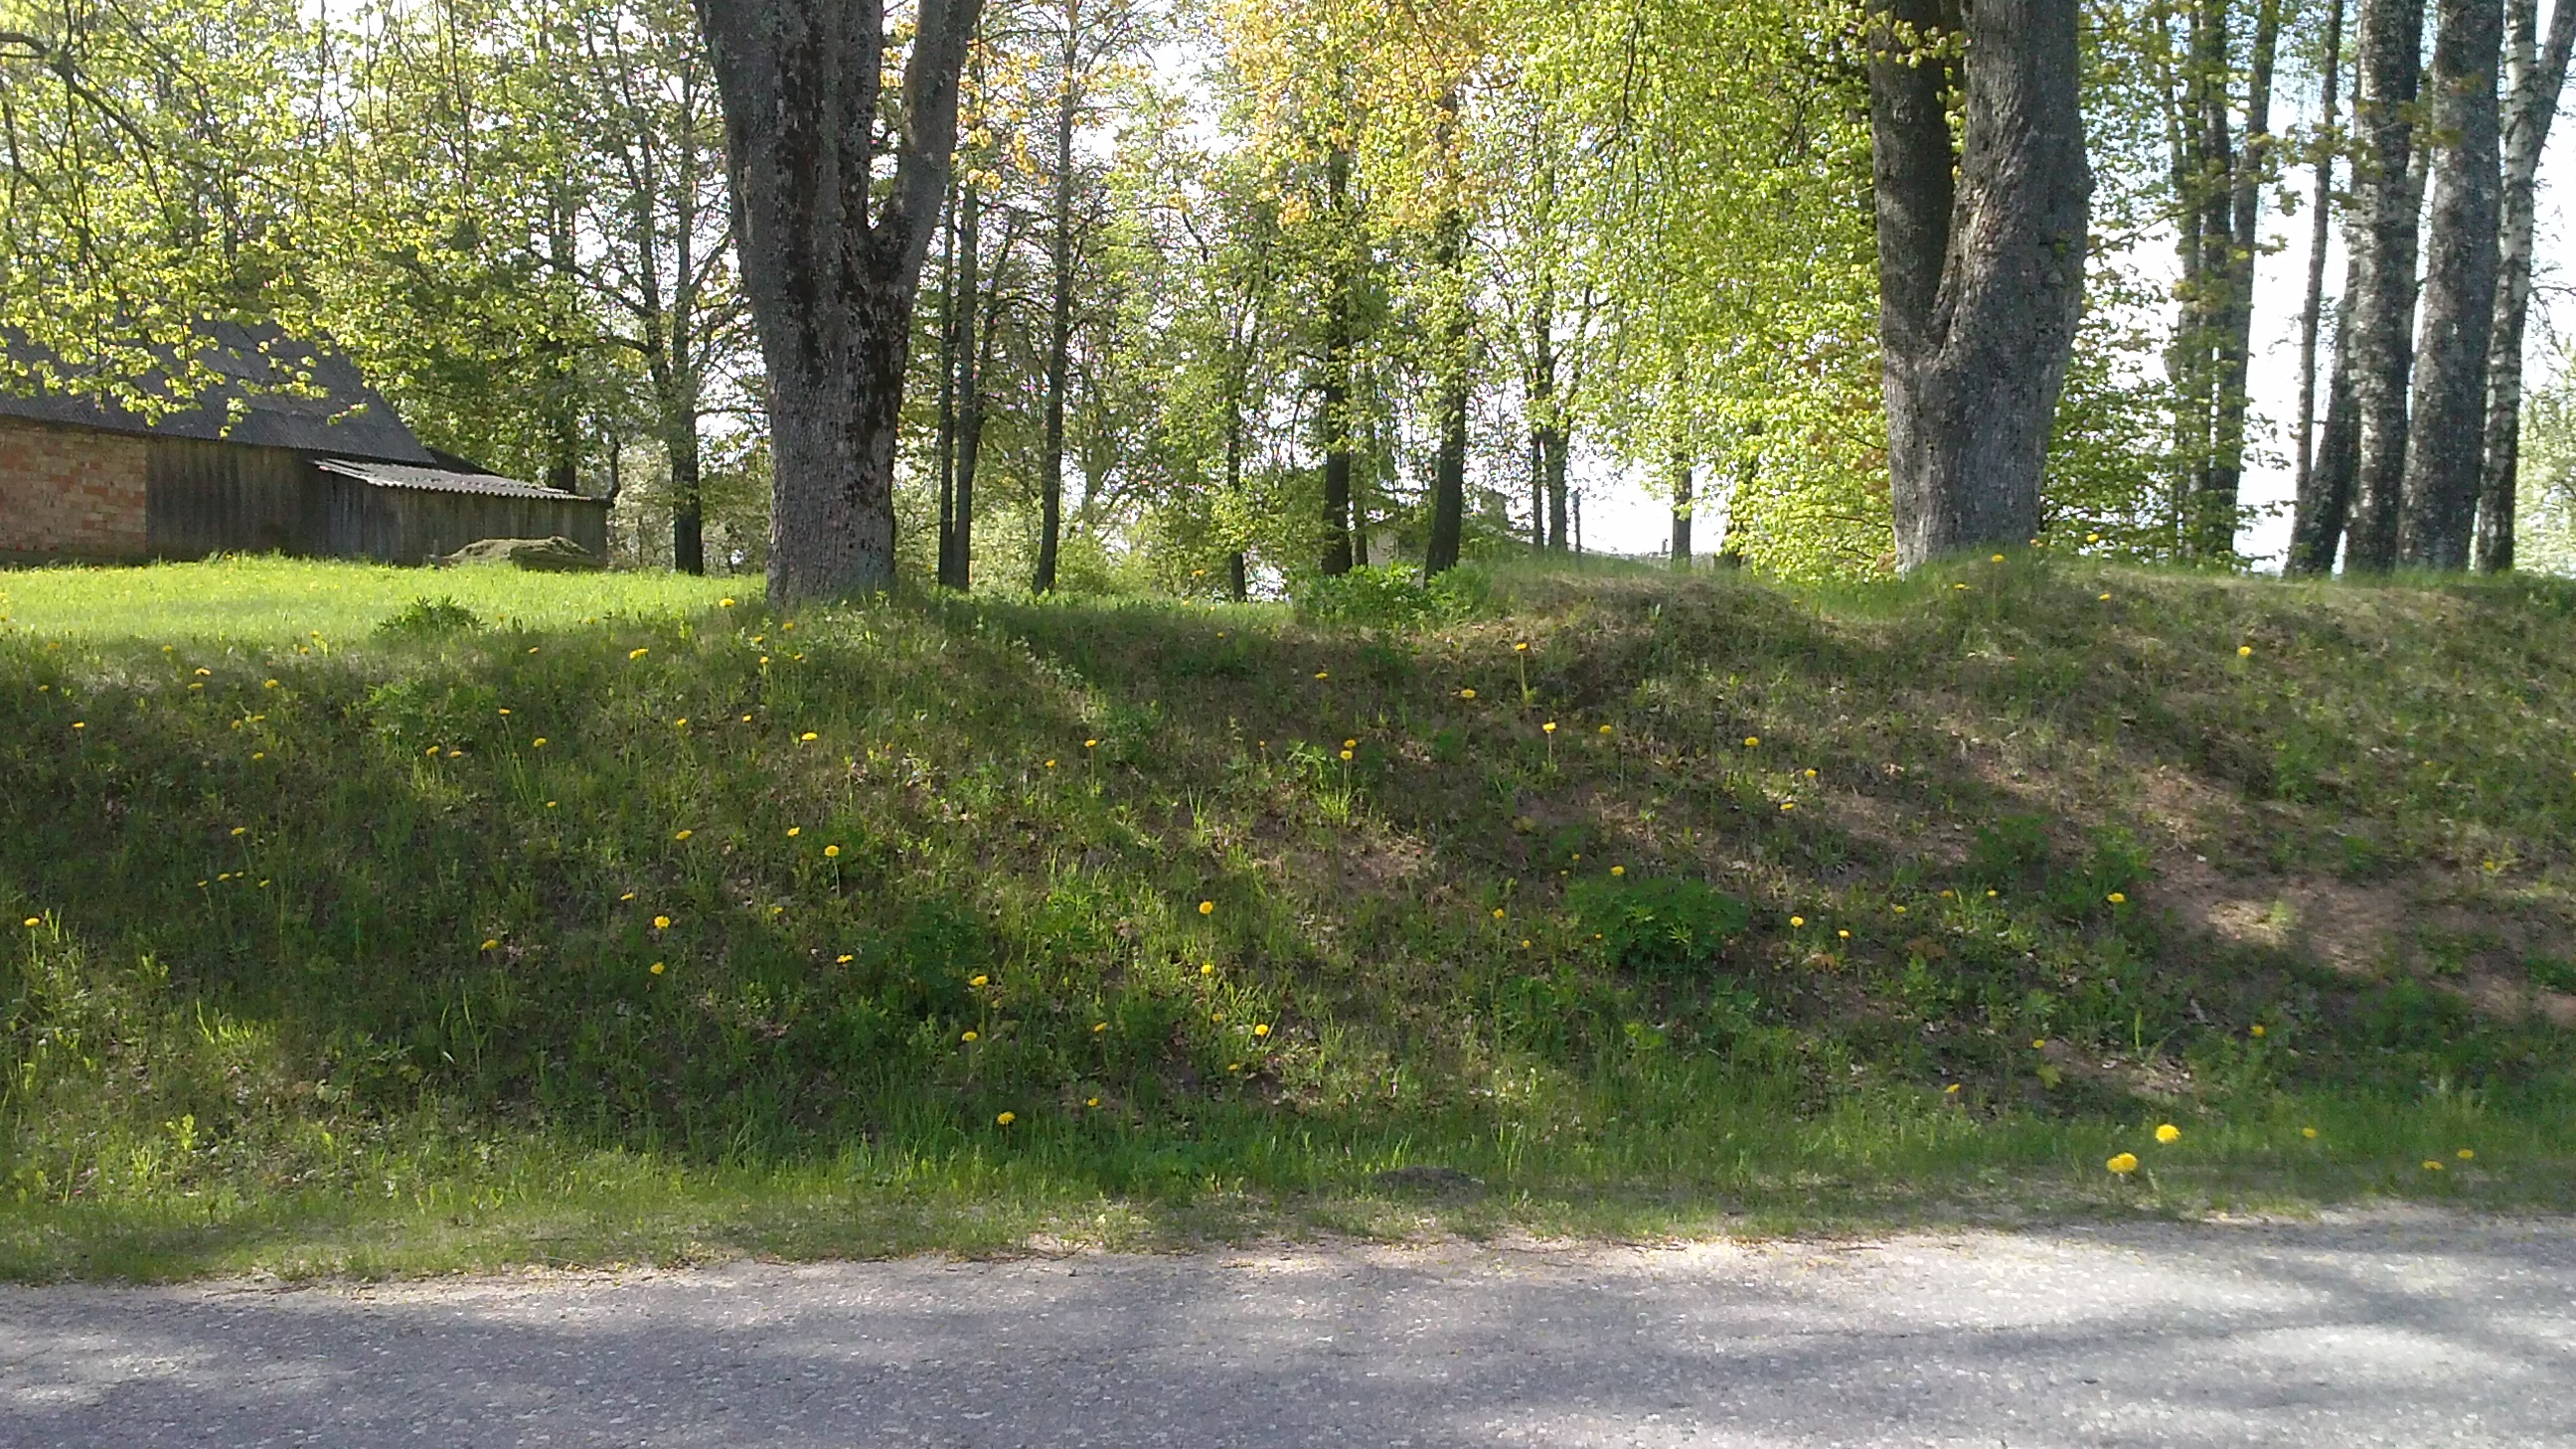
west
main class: Grassland
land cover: Grassland without tree/shrub cover
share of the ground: > 75 %
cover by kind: herbaceous plants 100 %
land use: Agriculture (excluding fallow land and kitchen gardens)
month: May
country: LV
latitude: 55.9712
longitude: 27.6020
